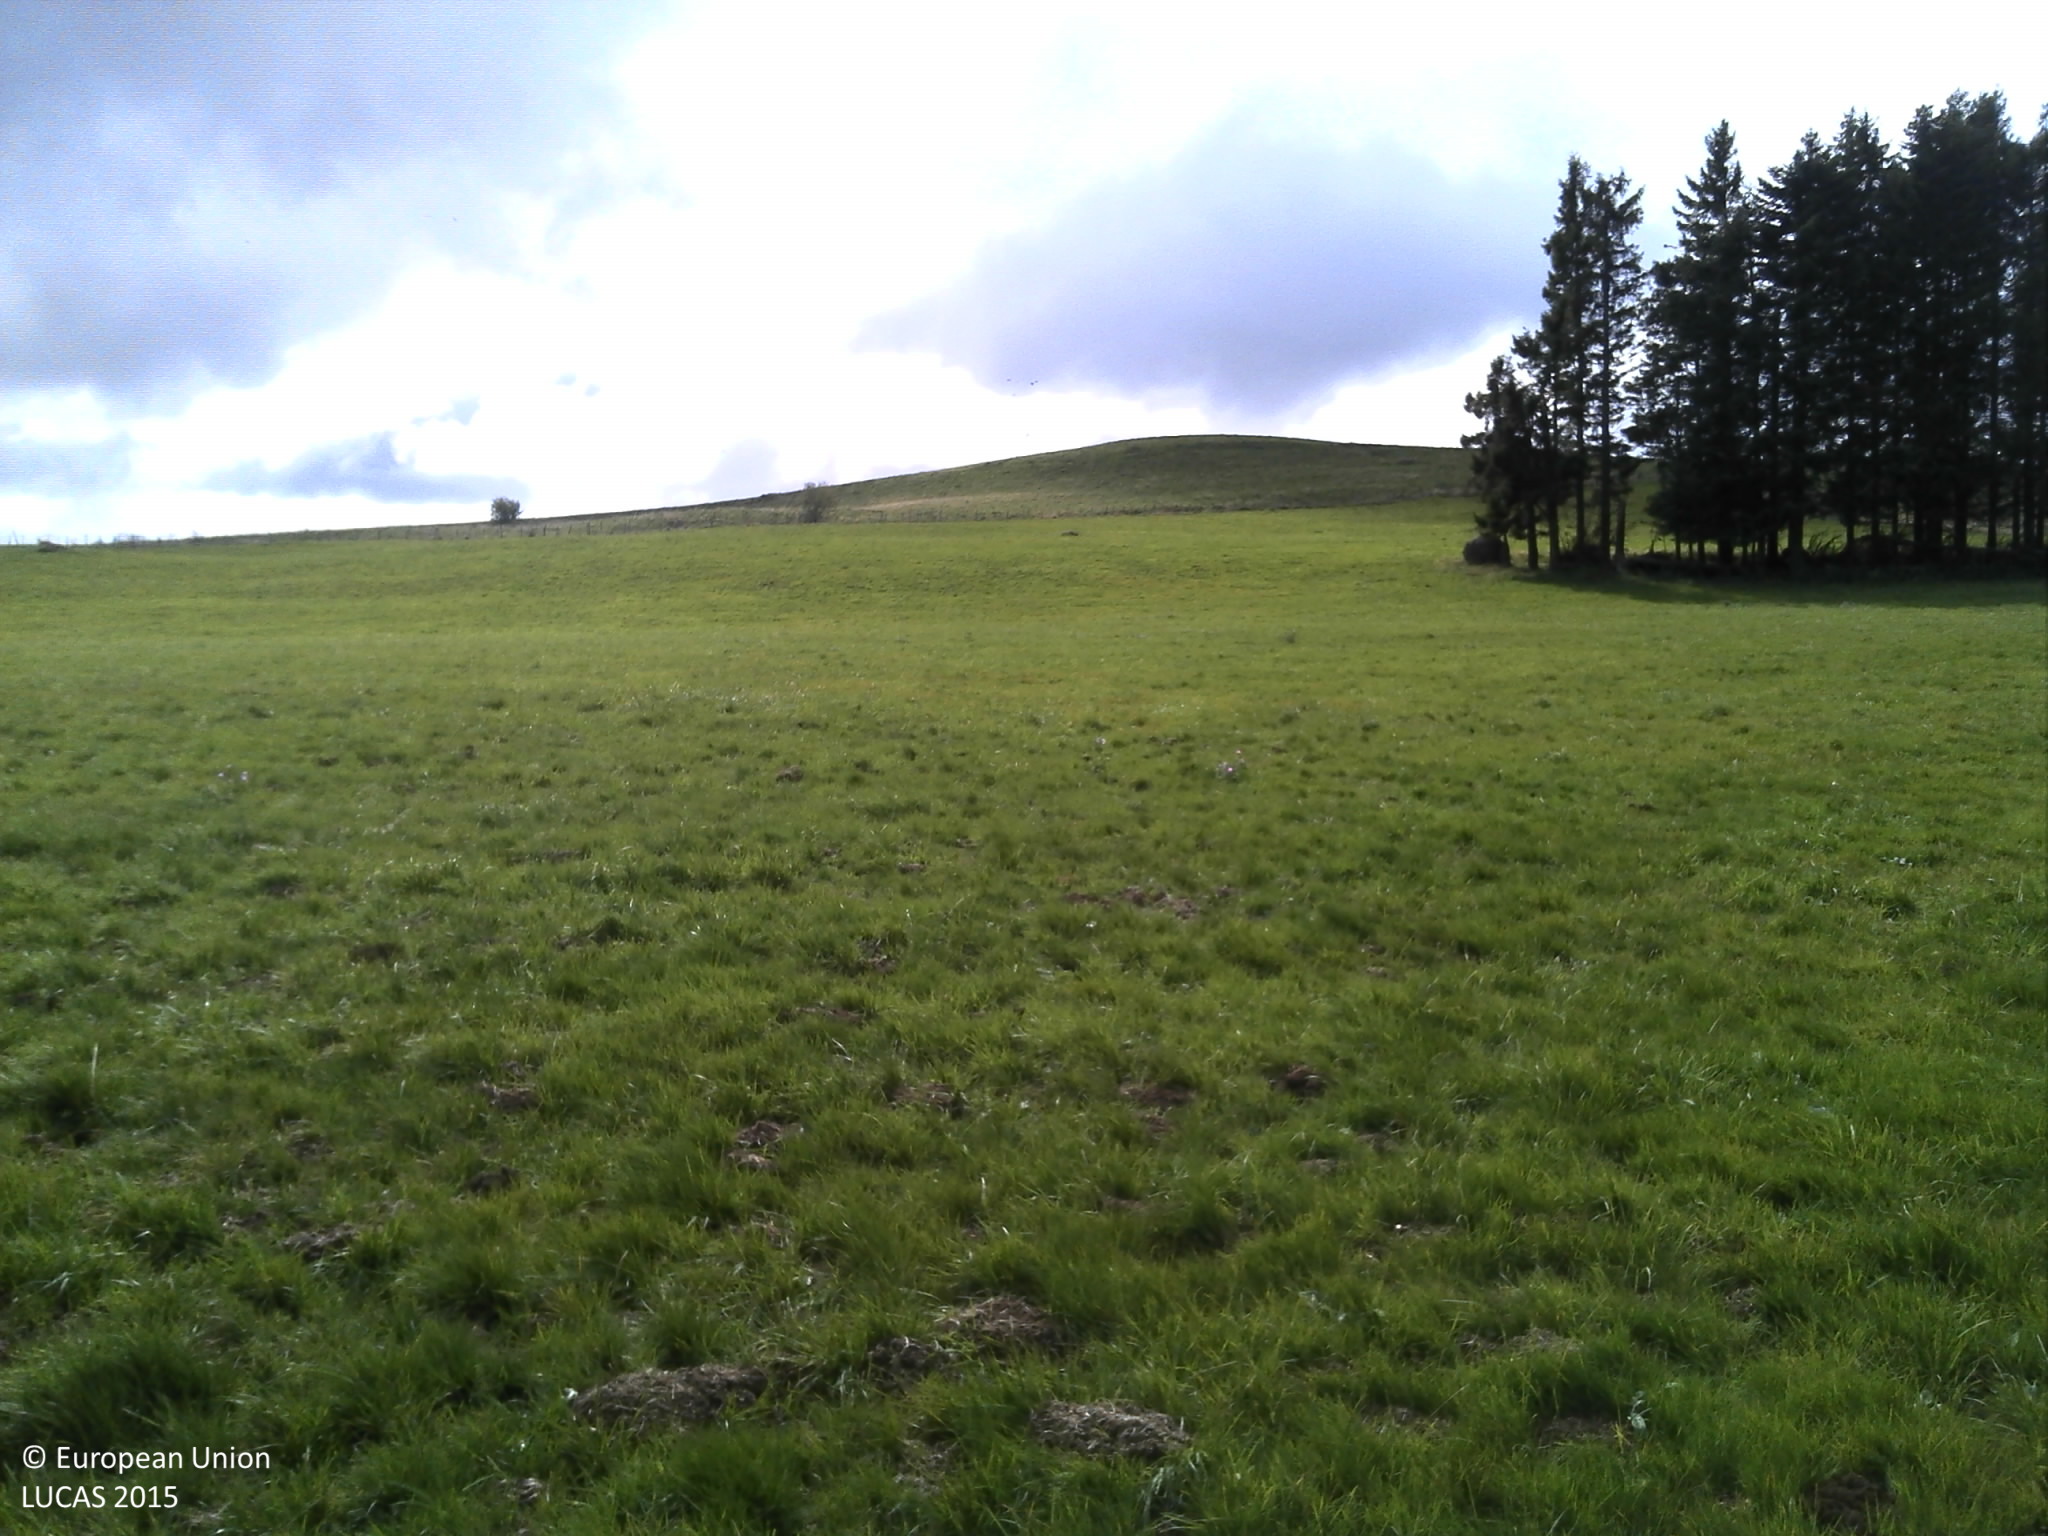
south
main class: Grassland
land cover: Grassland without tree/shrub cover
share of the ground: > 75 %
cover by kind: herbaceous plants 100 %
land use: Agriculture (excluding fallow land and kitchen gardens)
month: September
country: FR
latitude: 45.5019
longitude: 2.9227
